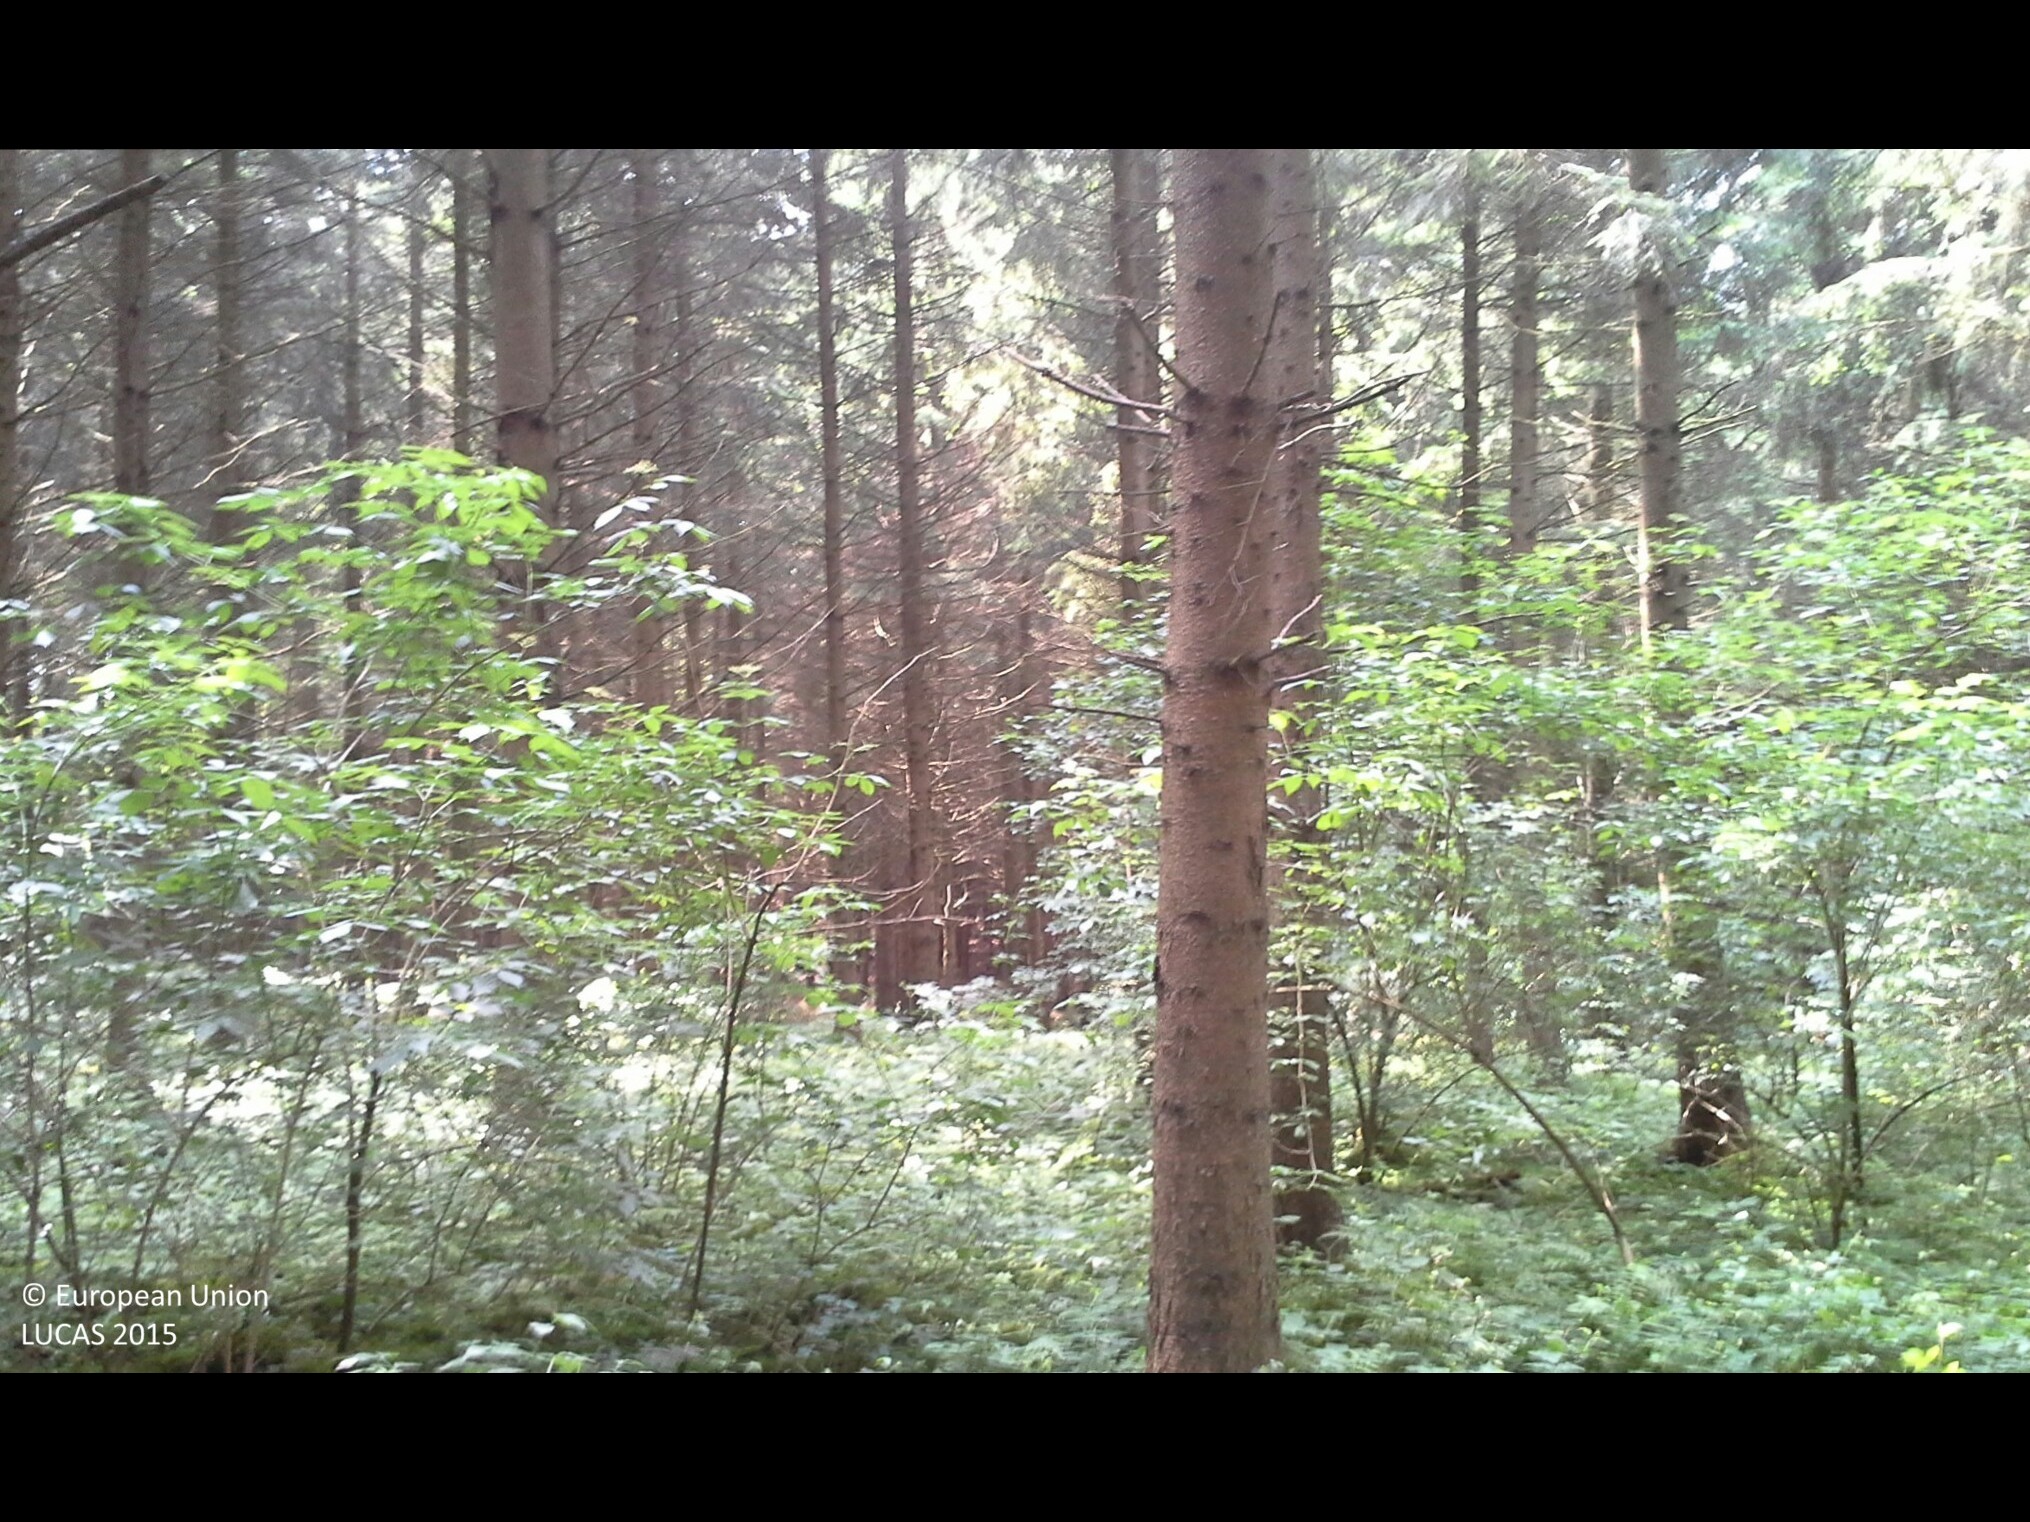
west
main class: Woodland
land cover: Spruce dominated coniferous woodland
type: hemiboreal forest and nemoral coniferous forest and mixed broadleaved-coniferous forest
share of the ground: > 75 %
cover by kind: coniferous forest trees 100 %
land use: Forestry
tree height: > 5 m
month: June
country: AT
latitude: 48.0663
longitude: 14.3345
